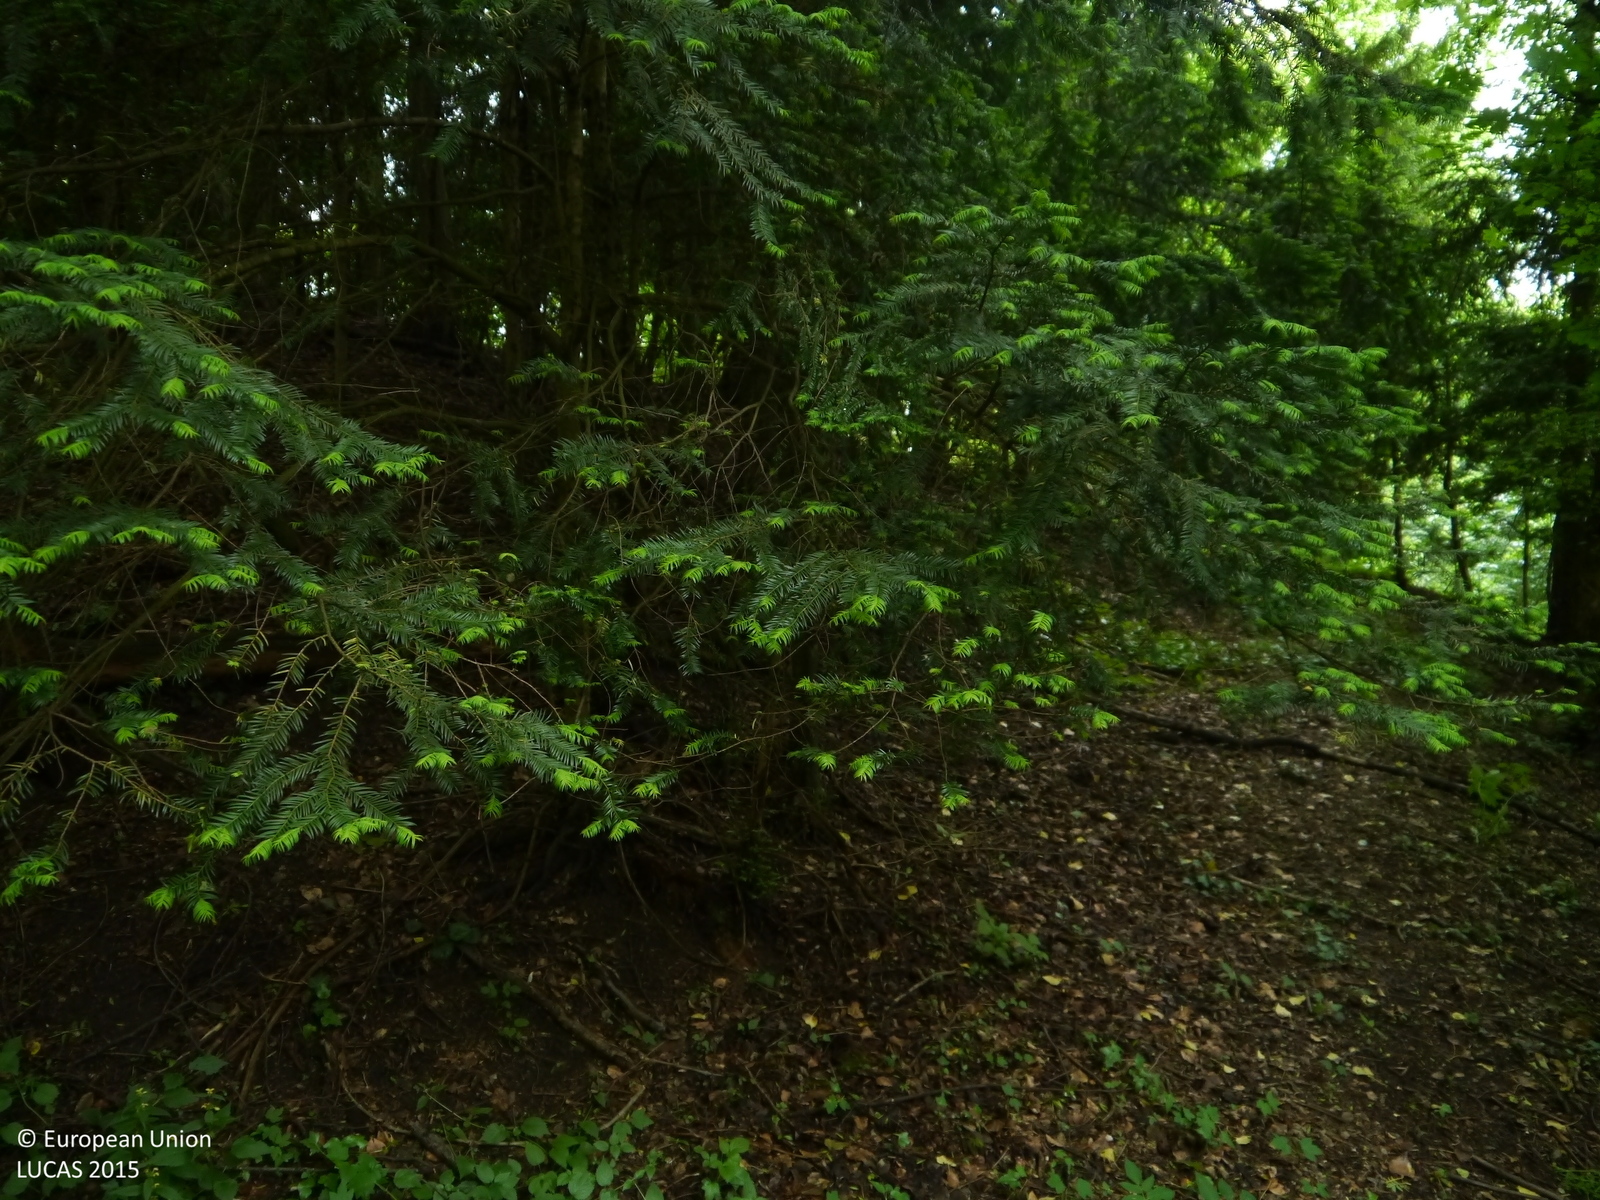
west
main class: Woodland
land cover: Broadleaved woodland
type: hemiboreal forest and nemoral coniferous forest and mixed broadleaved-coniferous forest
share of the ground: > 75 %
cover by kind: broadleaved forest trees 90 %, herbaceous plants 10 %
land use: Forestry
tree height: > 5 m
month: May
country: AT
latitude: 46.8928
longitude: 15.8936
